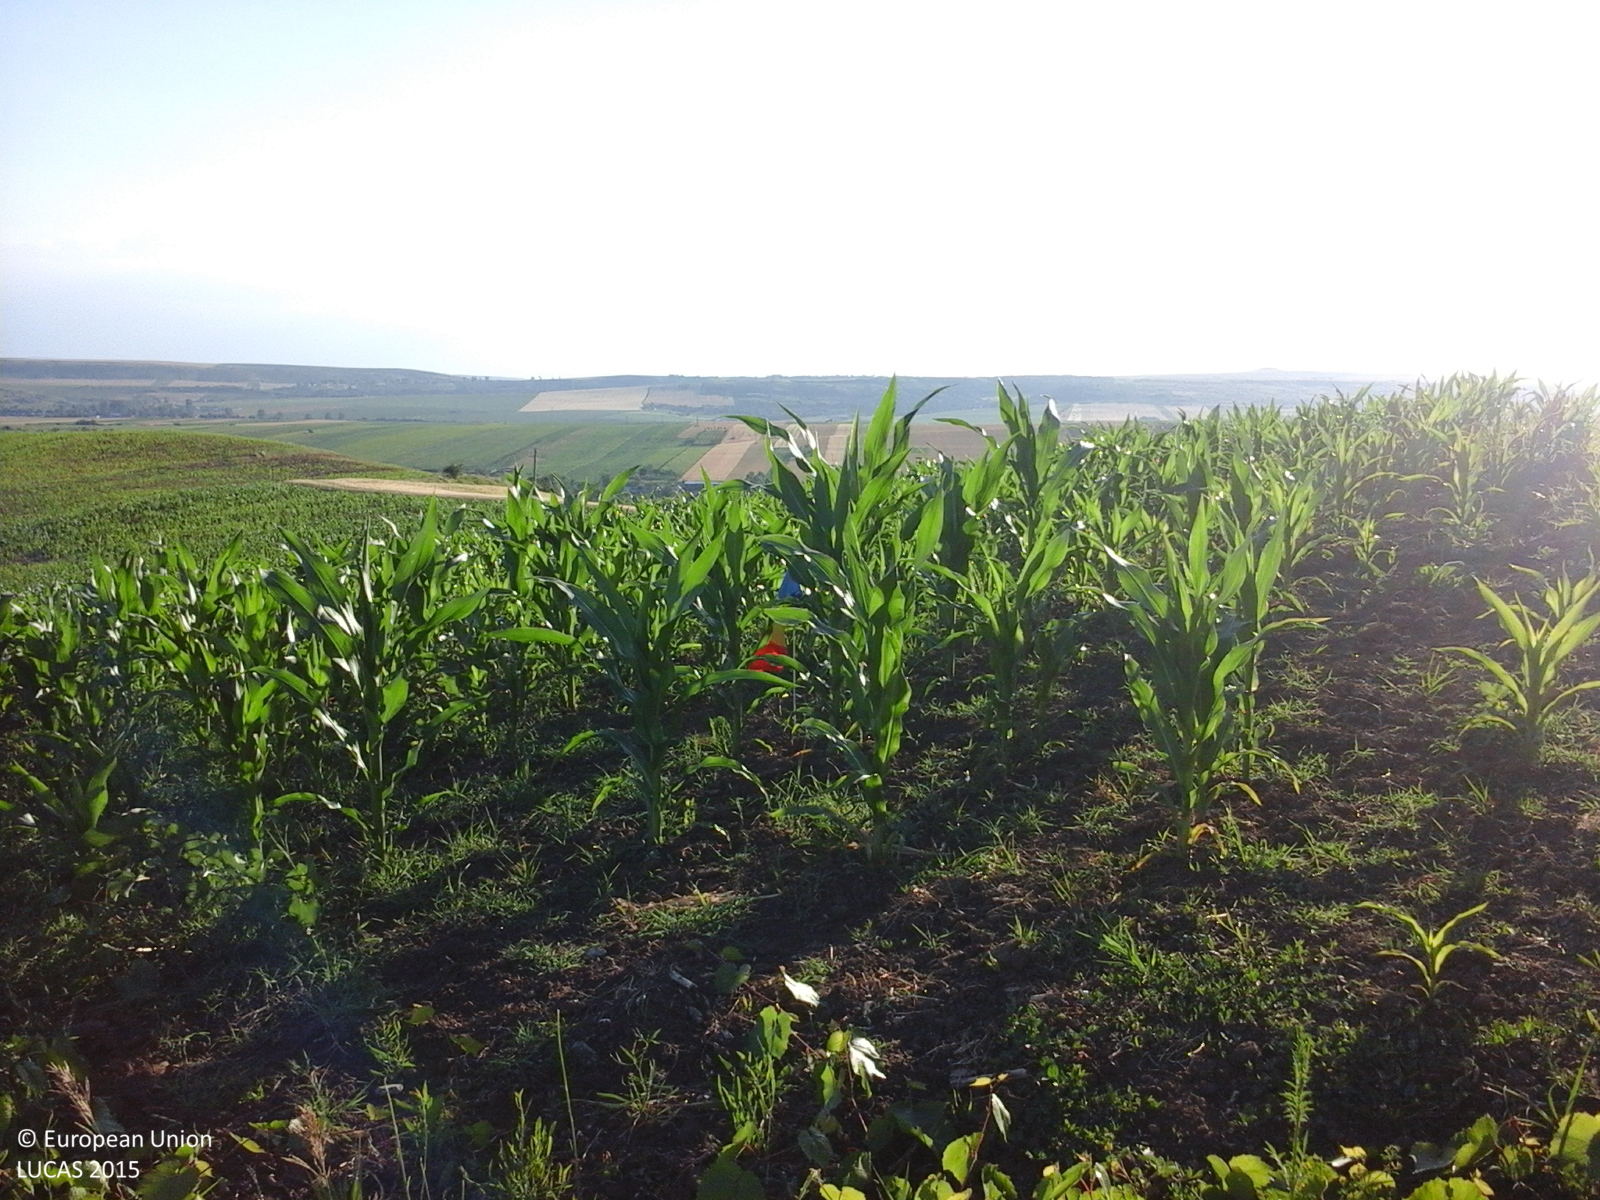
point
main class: Cropland
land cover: Maize
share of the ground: > 75 %
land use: Agriculture (excluding fallow land and kitchen gardens)
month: June
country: RO
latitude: 46.9394
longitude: 27.6017
